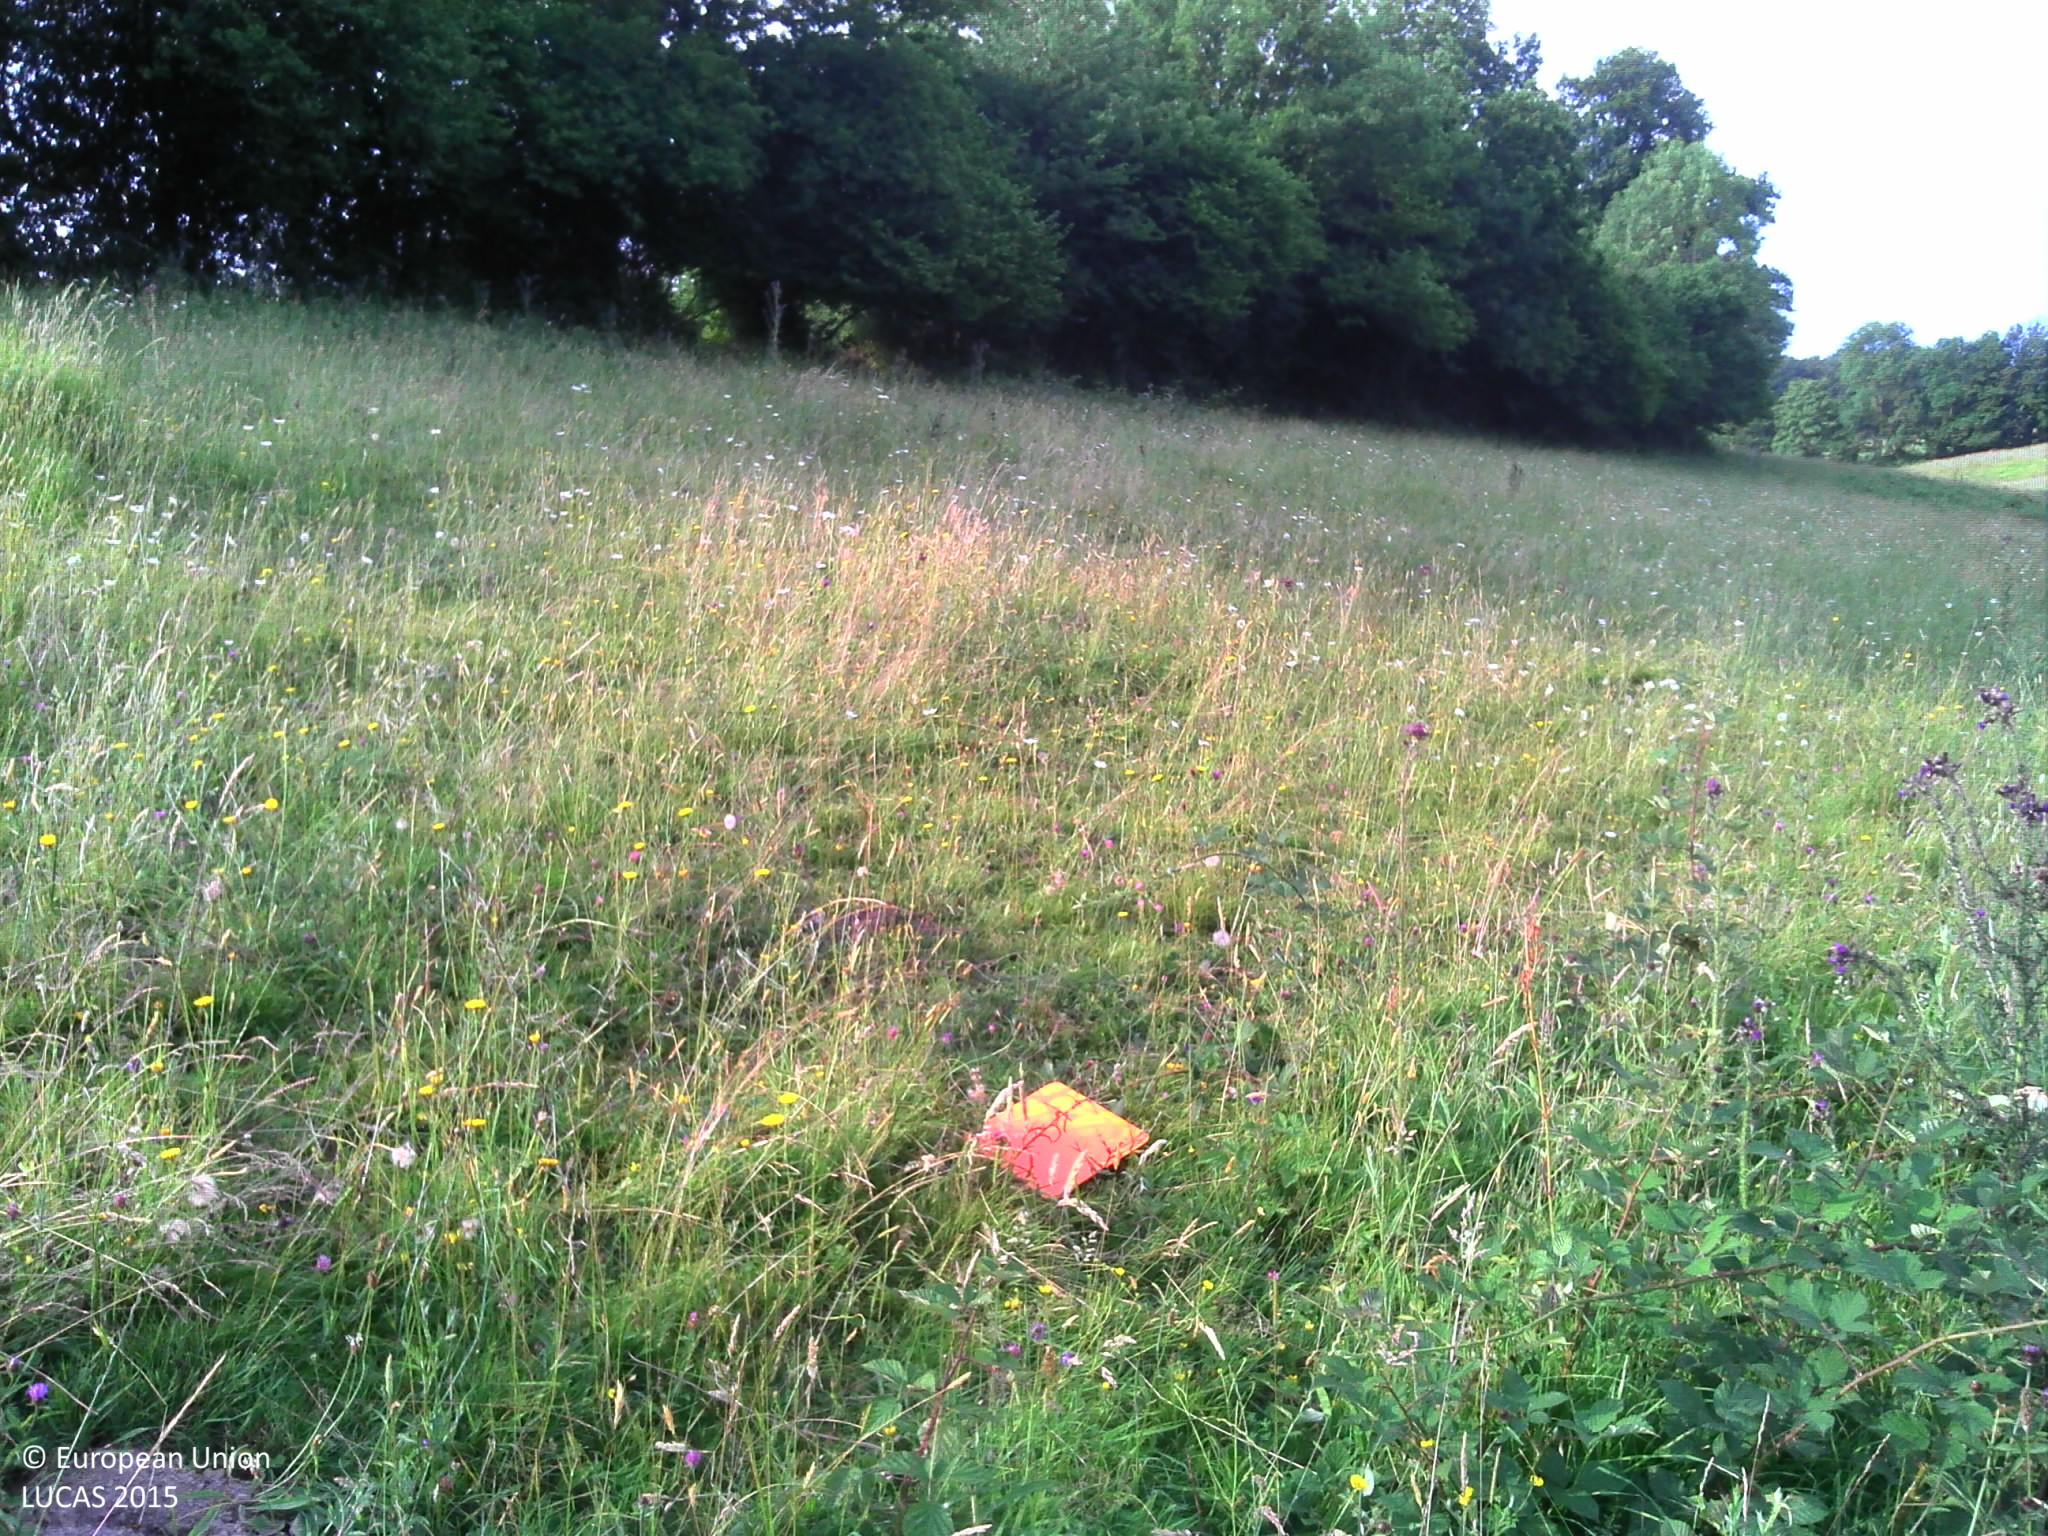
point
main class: Grassland
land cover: Grassland without tree/shrub cover
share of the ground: > 75 %
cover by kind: herbaceous plants 100 %
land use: Agriculture (excluding fallow land and kitchen gardens)
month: July
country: FR
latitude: 48.9903
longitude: 0.0895
